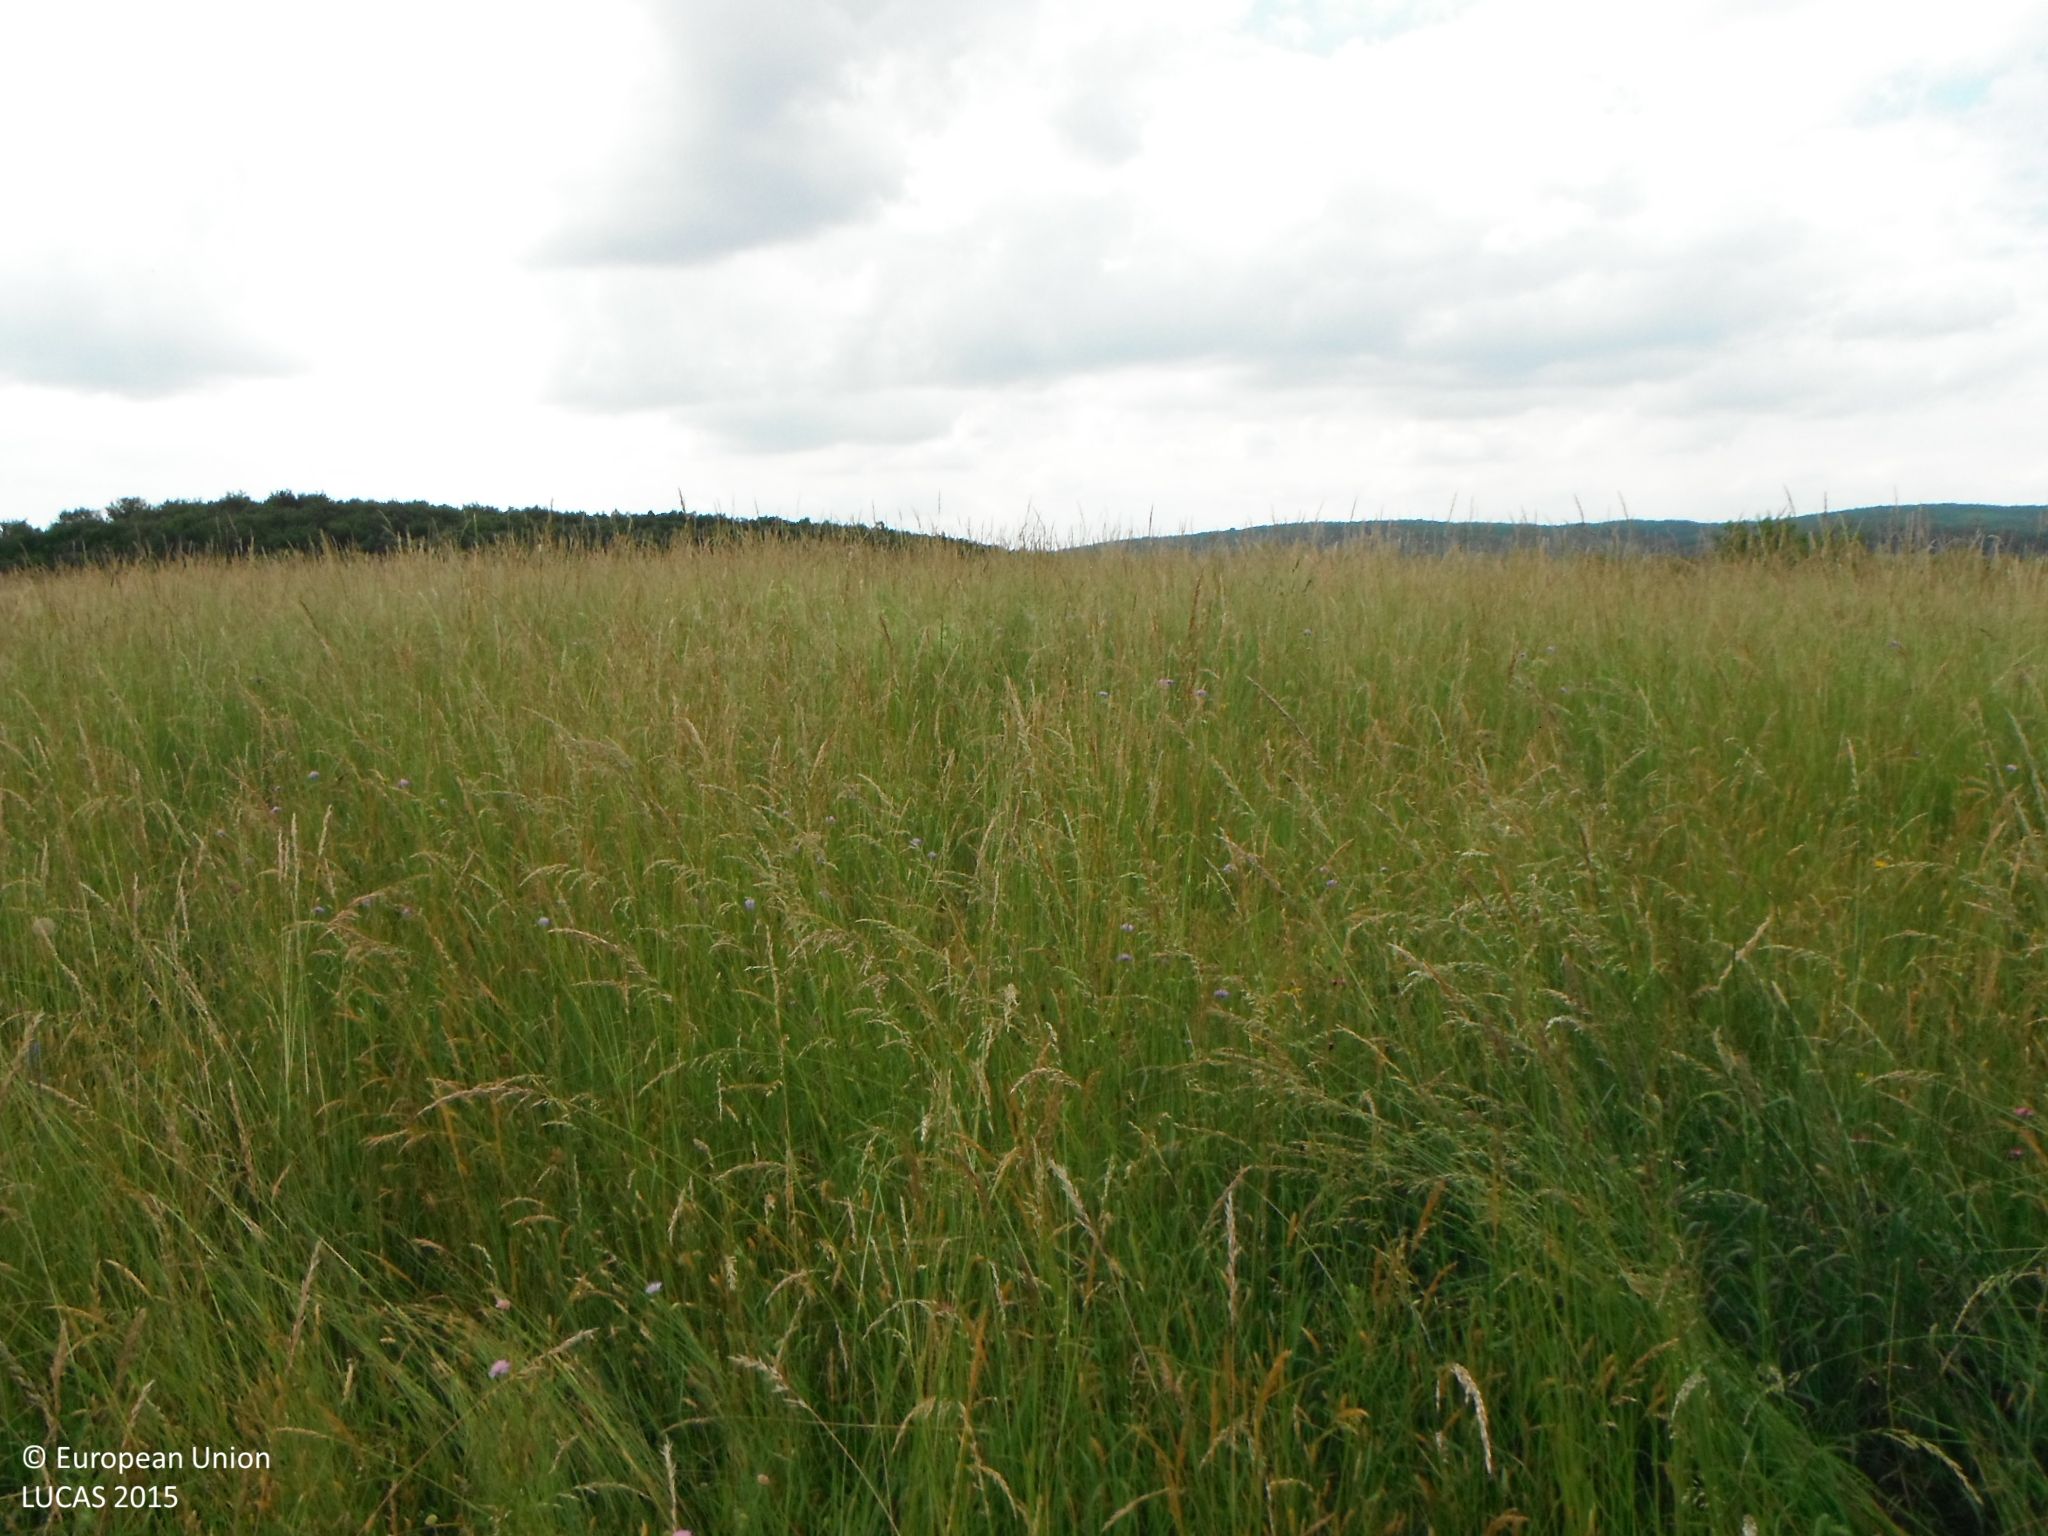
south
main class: Grassland
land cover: Grassland without tree/shrub cover
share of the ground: > 75 %
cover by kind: herbaceous plants 100 %
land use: Agriculture (excluding fallow land and kitchen gardens)
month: June
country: SK
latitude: 48.5939
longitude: 19.0377
